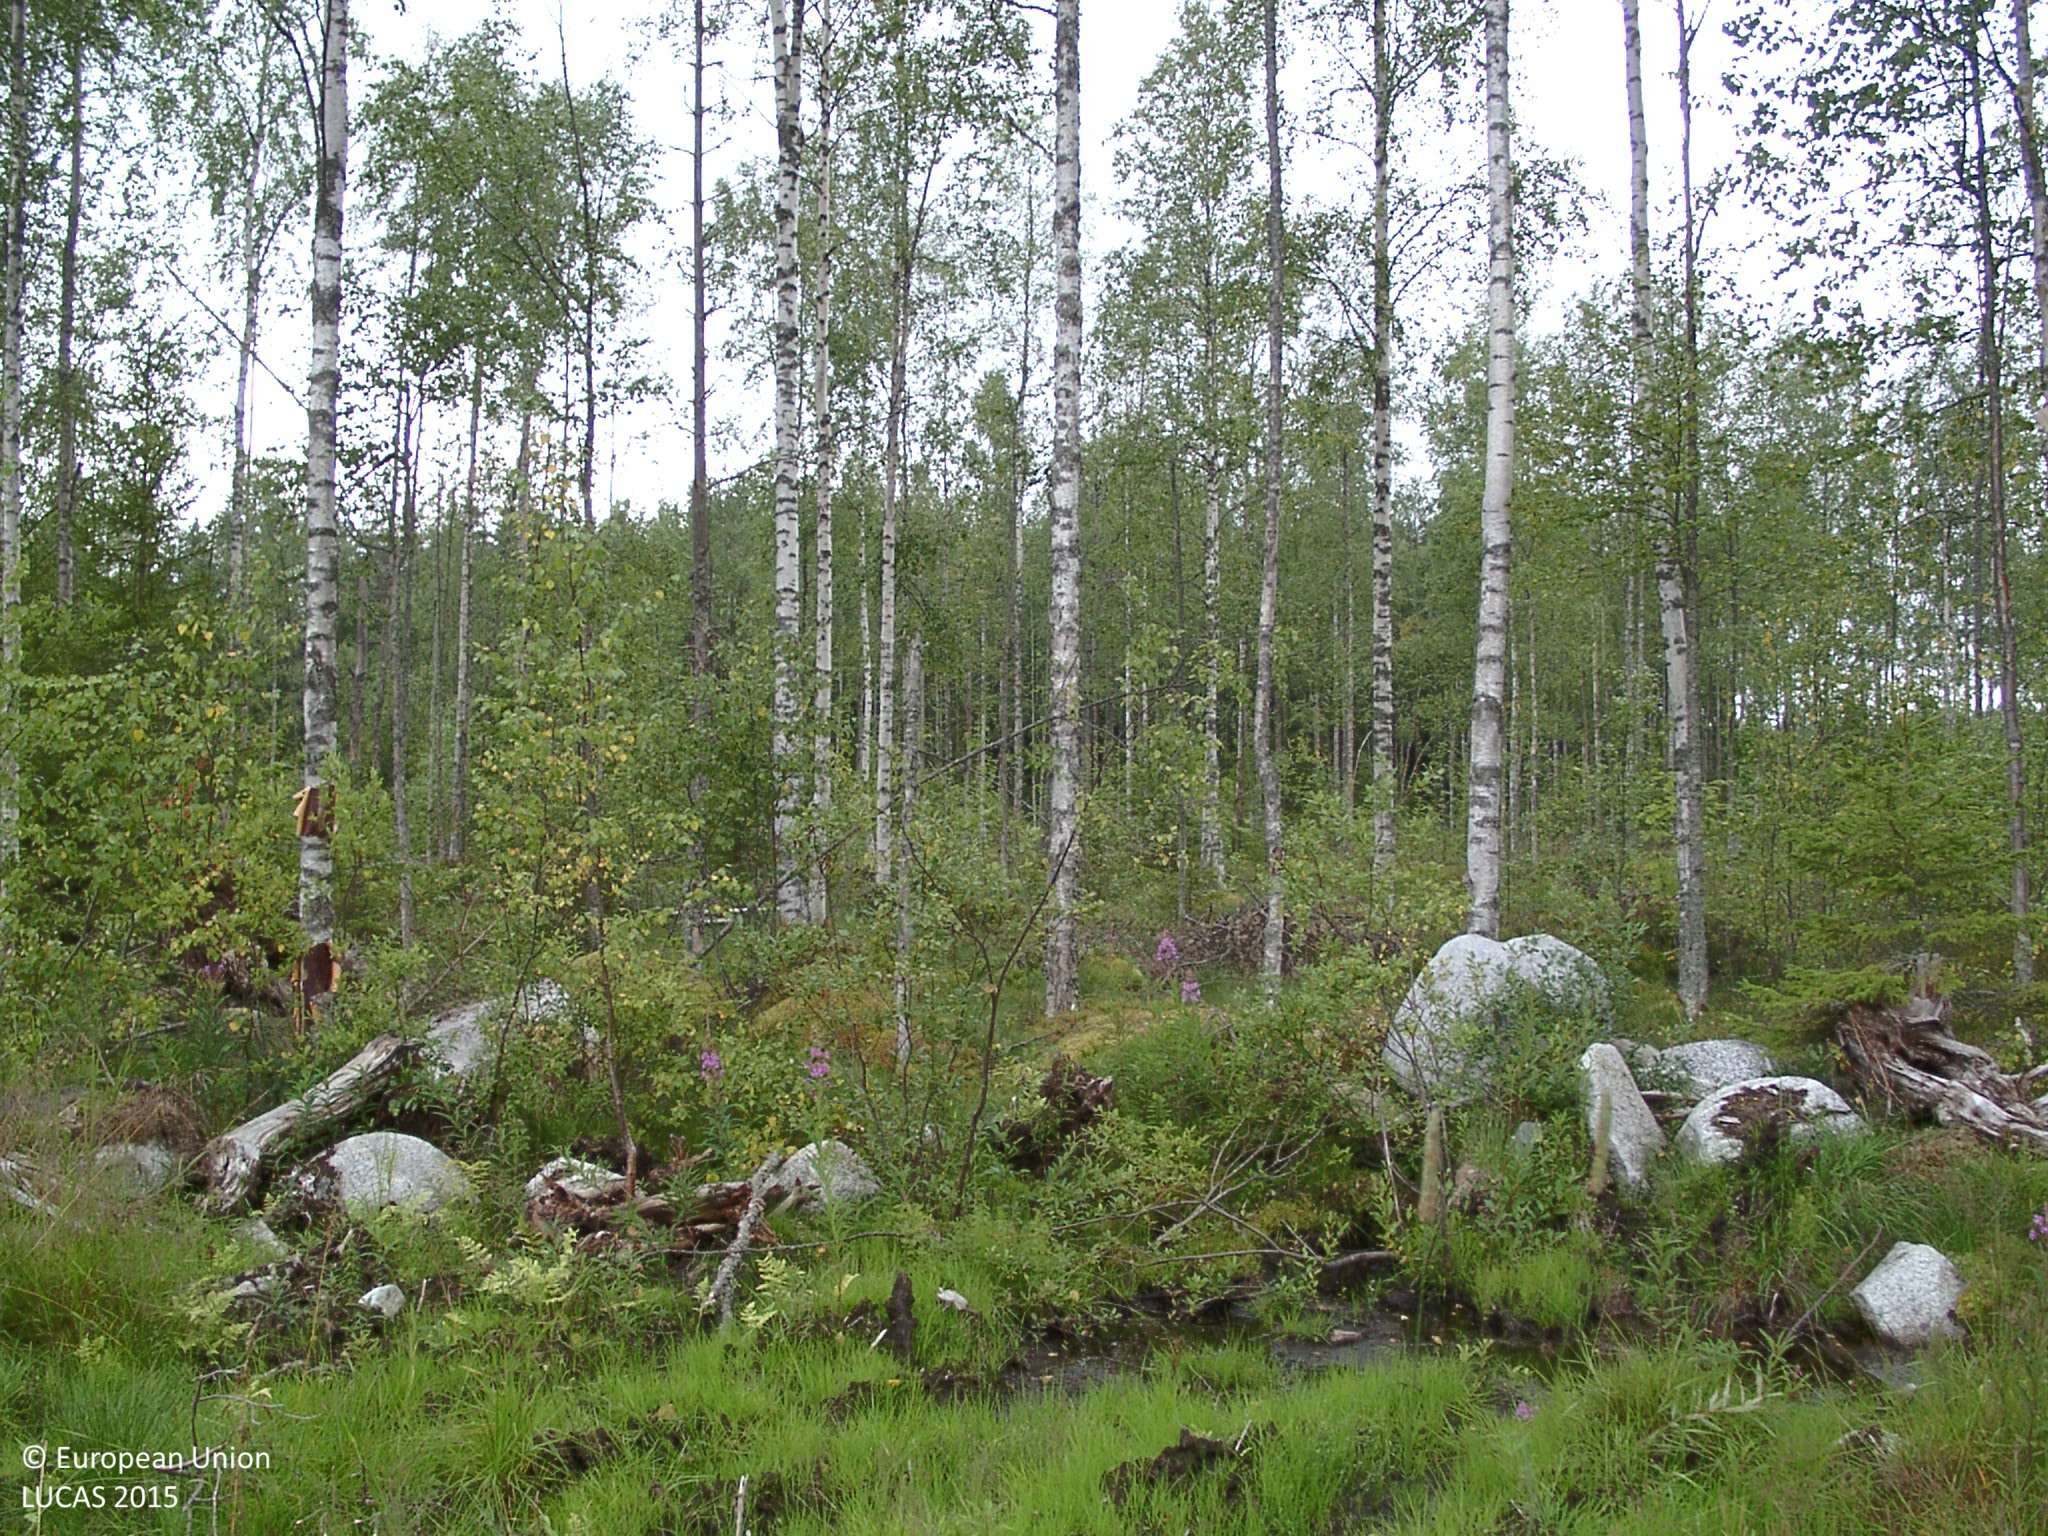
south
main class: Grassland
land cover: Grassland without tree/shrub cover
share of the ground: > 75 %
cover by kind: herbaceous plants 90 %, unconsolidated bare surface 10 %
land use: Agriculture (excluding fallow land and kitchen gardens)
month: August
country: FI
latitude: 62.8479
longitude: 24.6437
